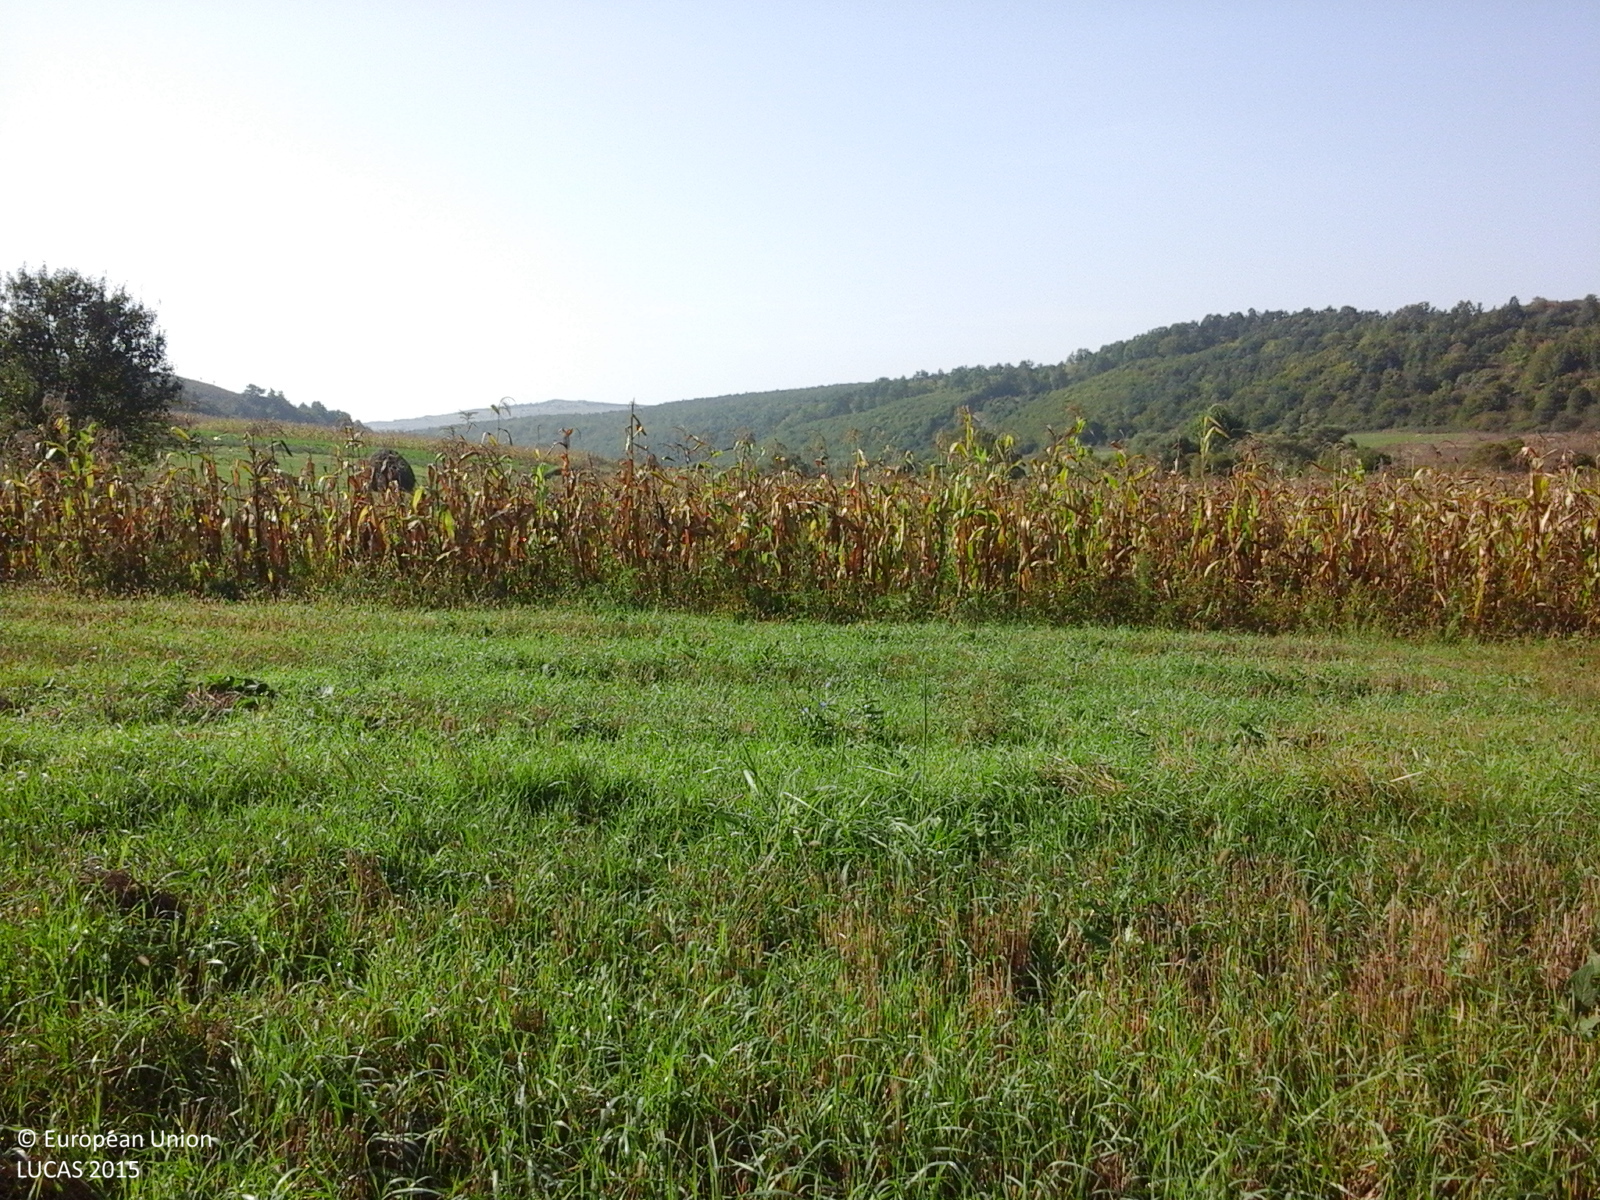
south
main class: Grassland
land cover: Grassland without tree/shrub cover
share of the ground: > 75 %
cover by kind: herbaceous plants 100 %
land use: Agriculture (excluding fallow land and kitchen gardens)
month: September
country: RO
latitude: 47.0673
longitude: 23.7303
